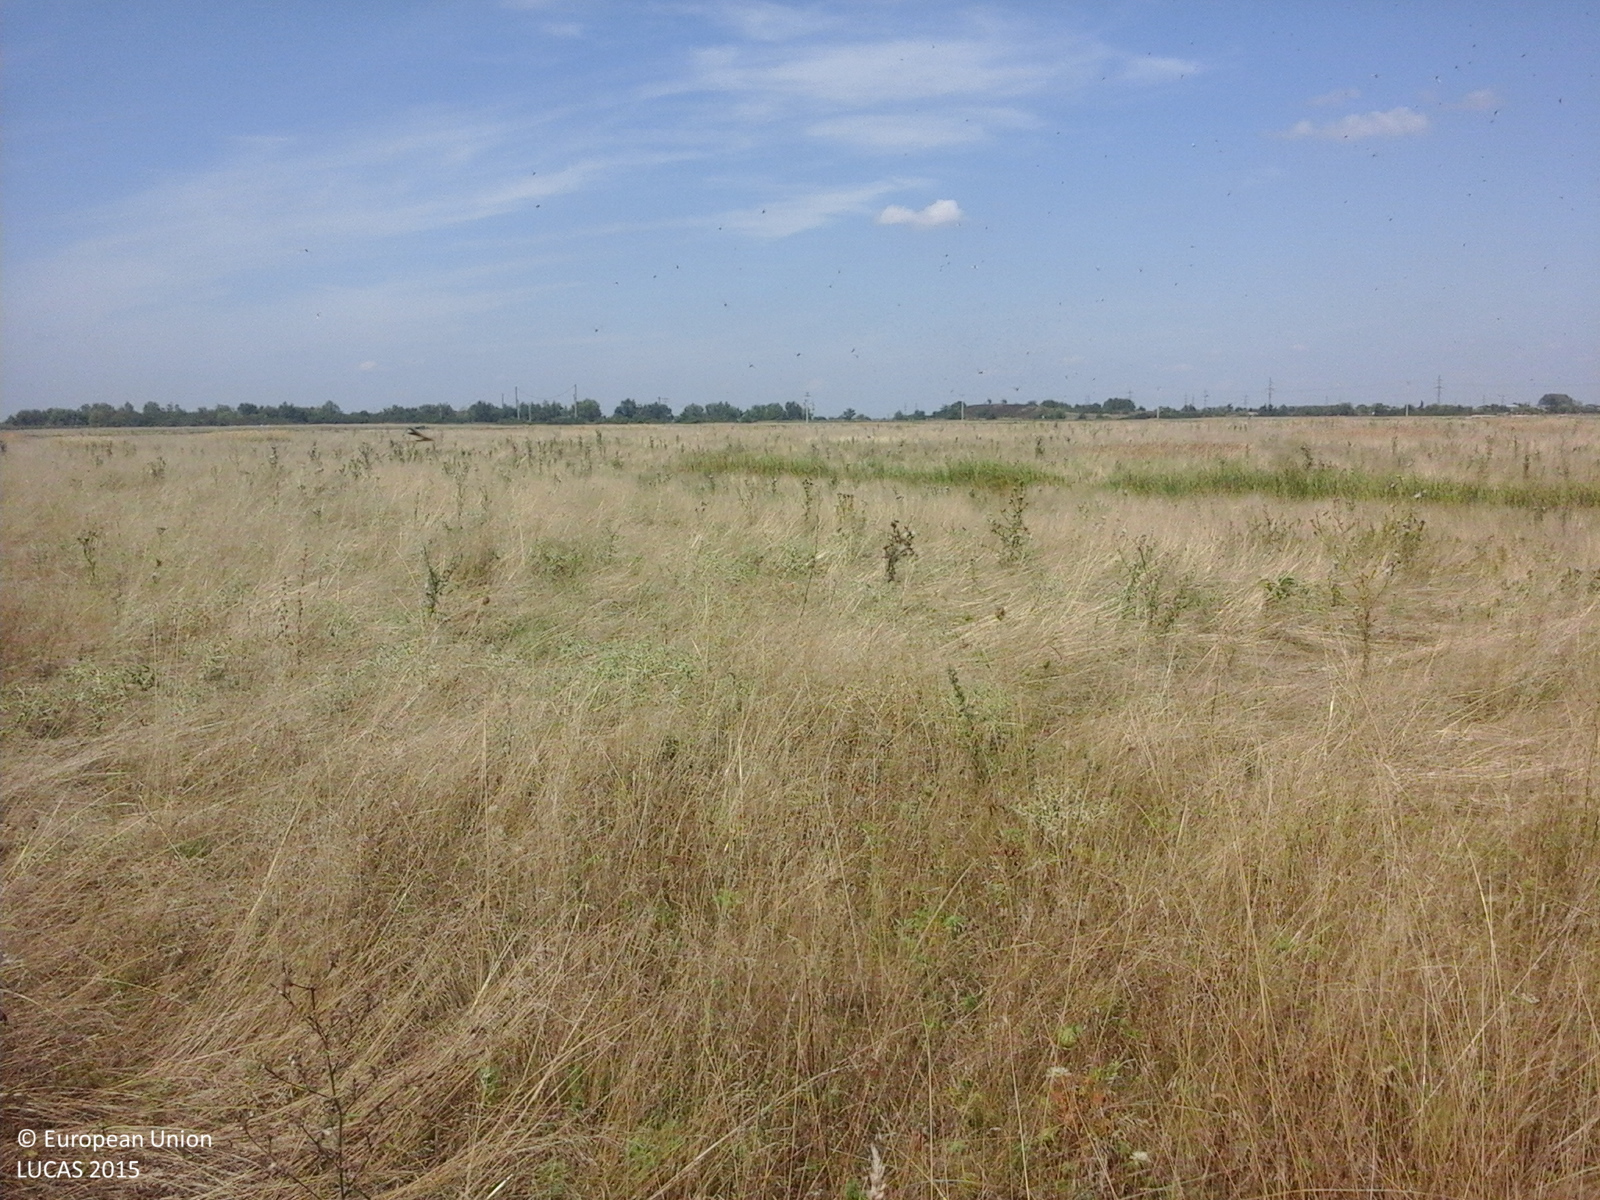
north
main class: Grassland
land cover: Spontaneously vegetated surfaces
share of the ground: > 75 %
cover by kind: herbaceous plants 100 %
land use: Fallow land
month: August
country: RO
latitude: 45.7278
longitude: 21.1703
